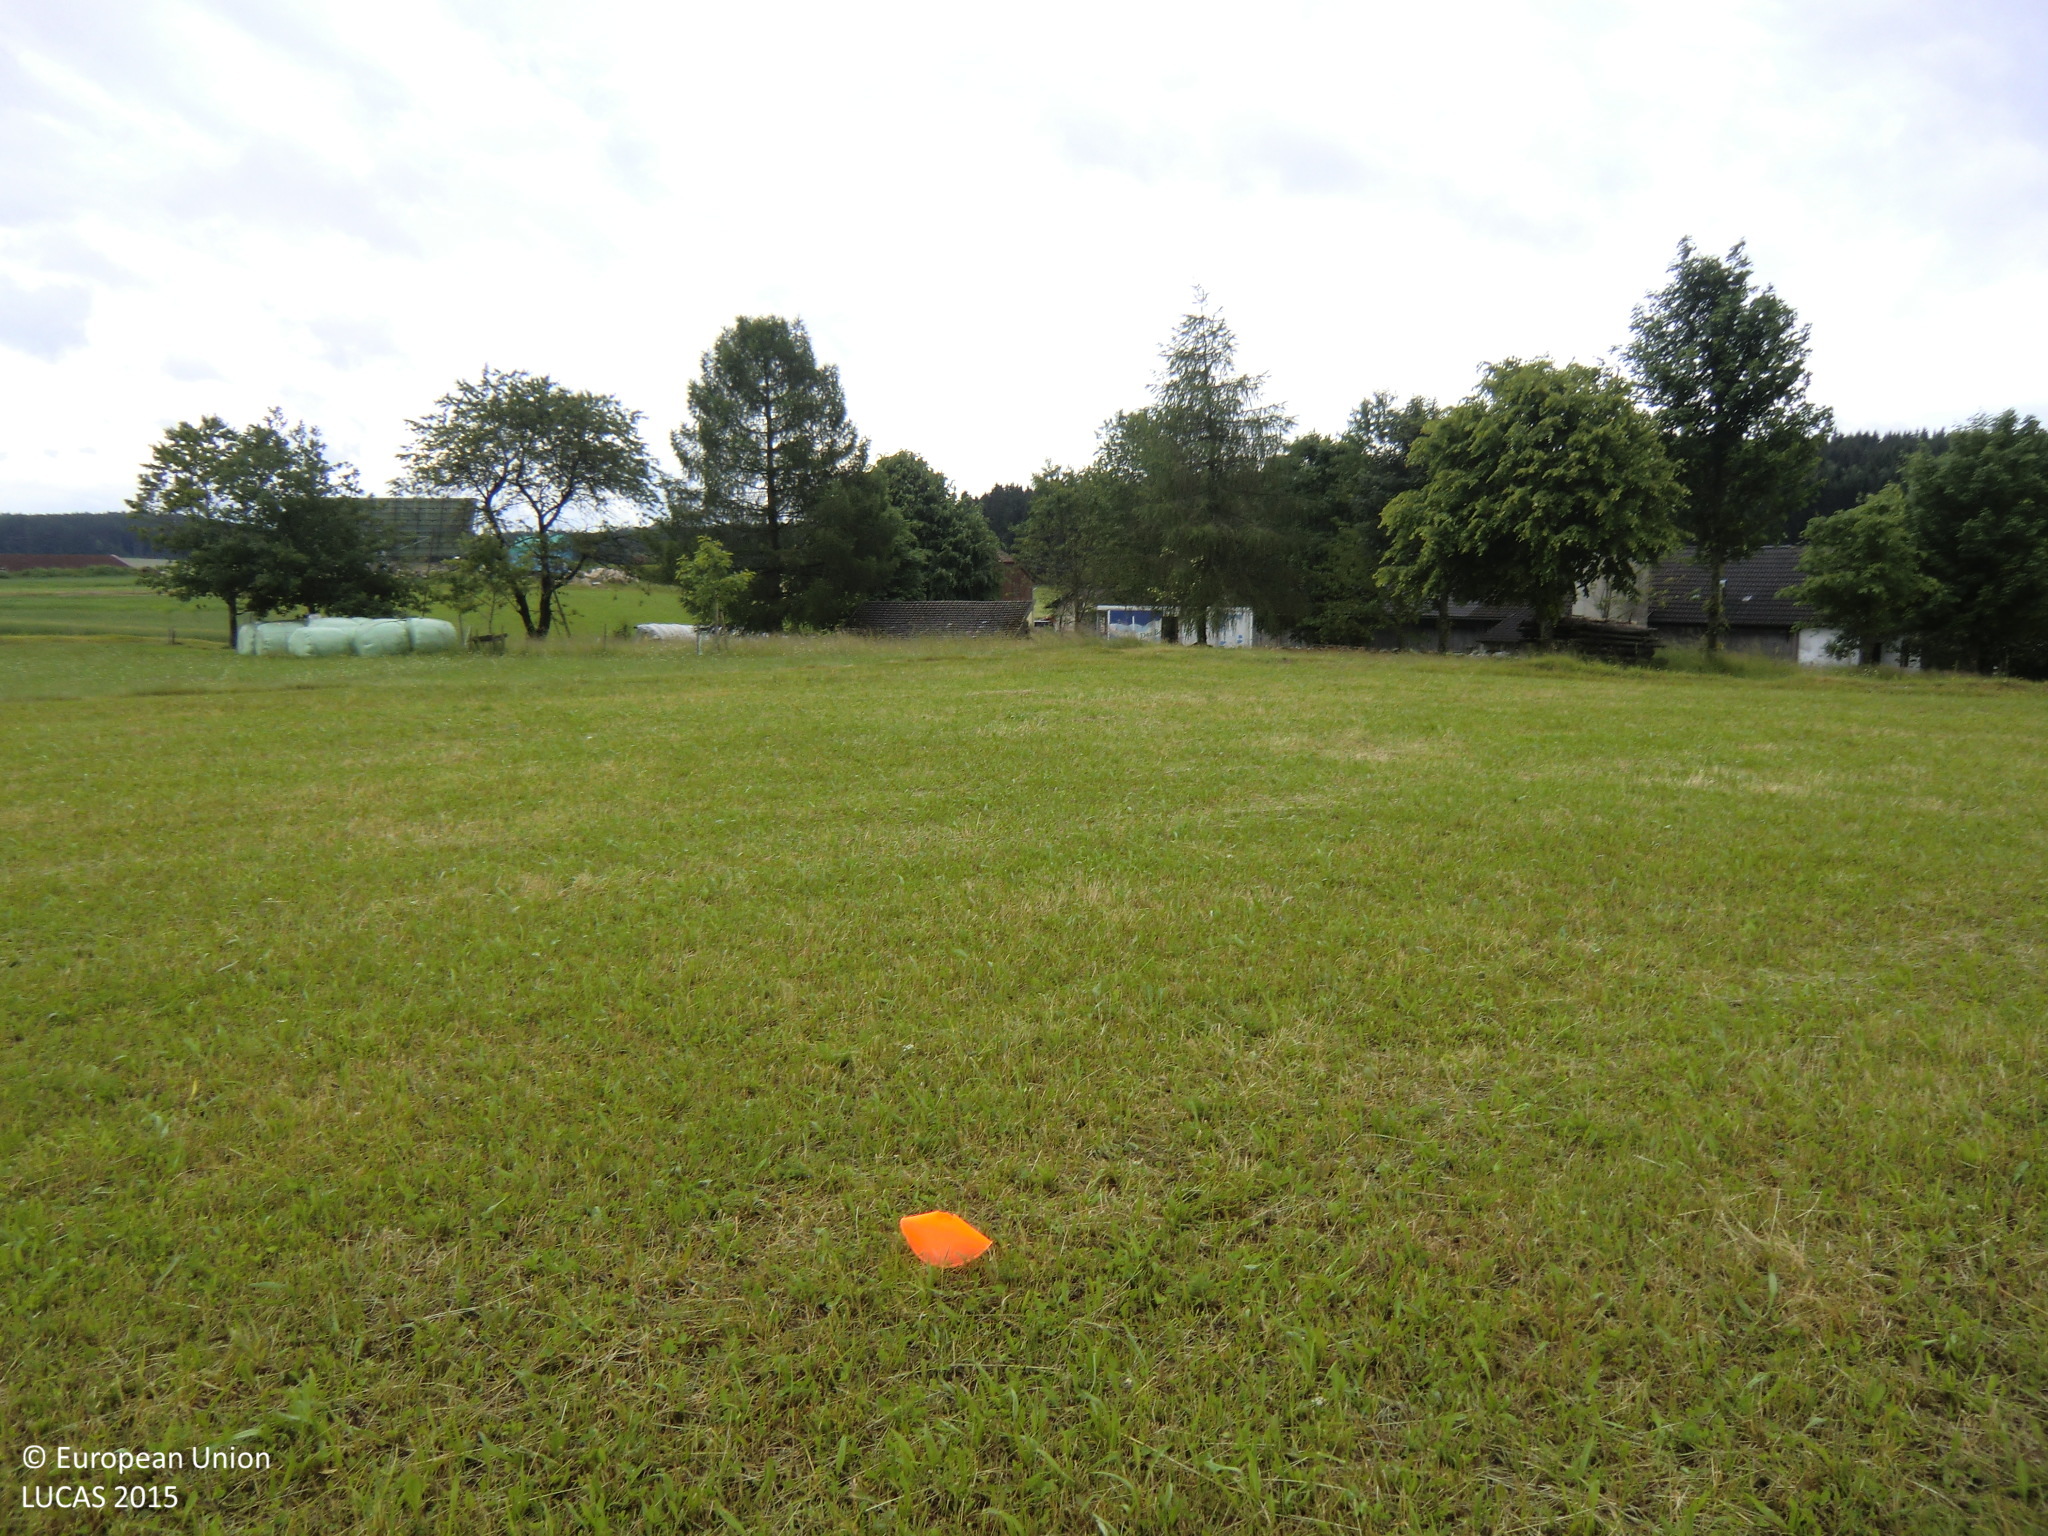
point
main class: Grassland
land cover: Grassland without tree/shrub cover
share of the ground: > 75 %
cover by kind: herbaceous plants 100 %
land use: Agriculture (excluding fallow land and kitchen gardens)
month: June
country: AT
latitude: 48.5435
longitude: 14.5656
